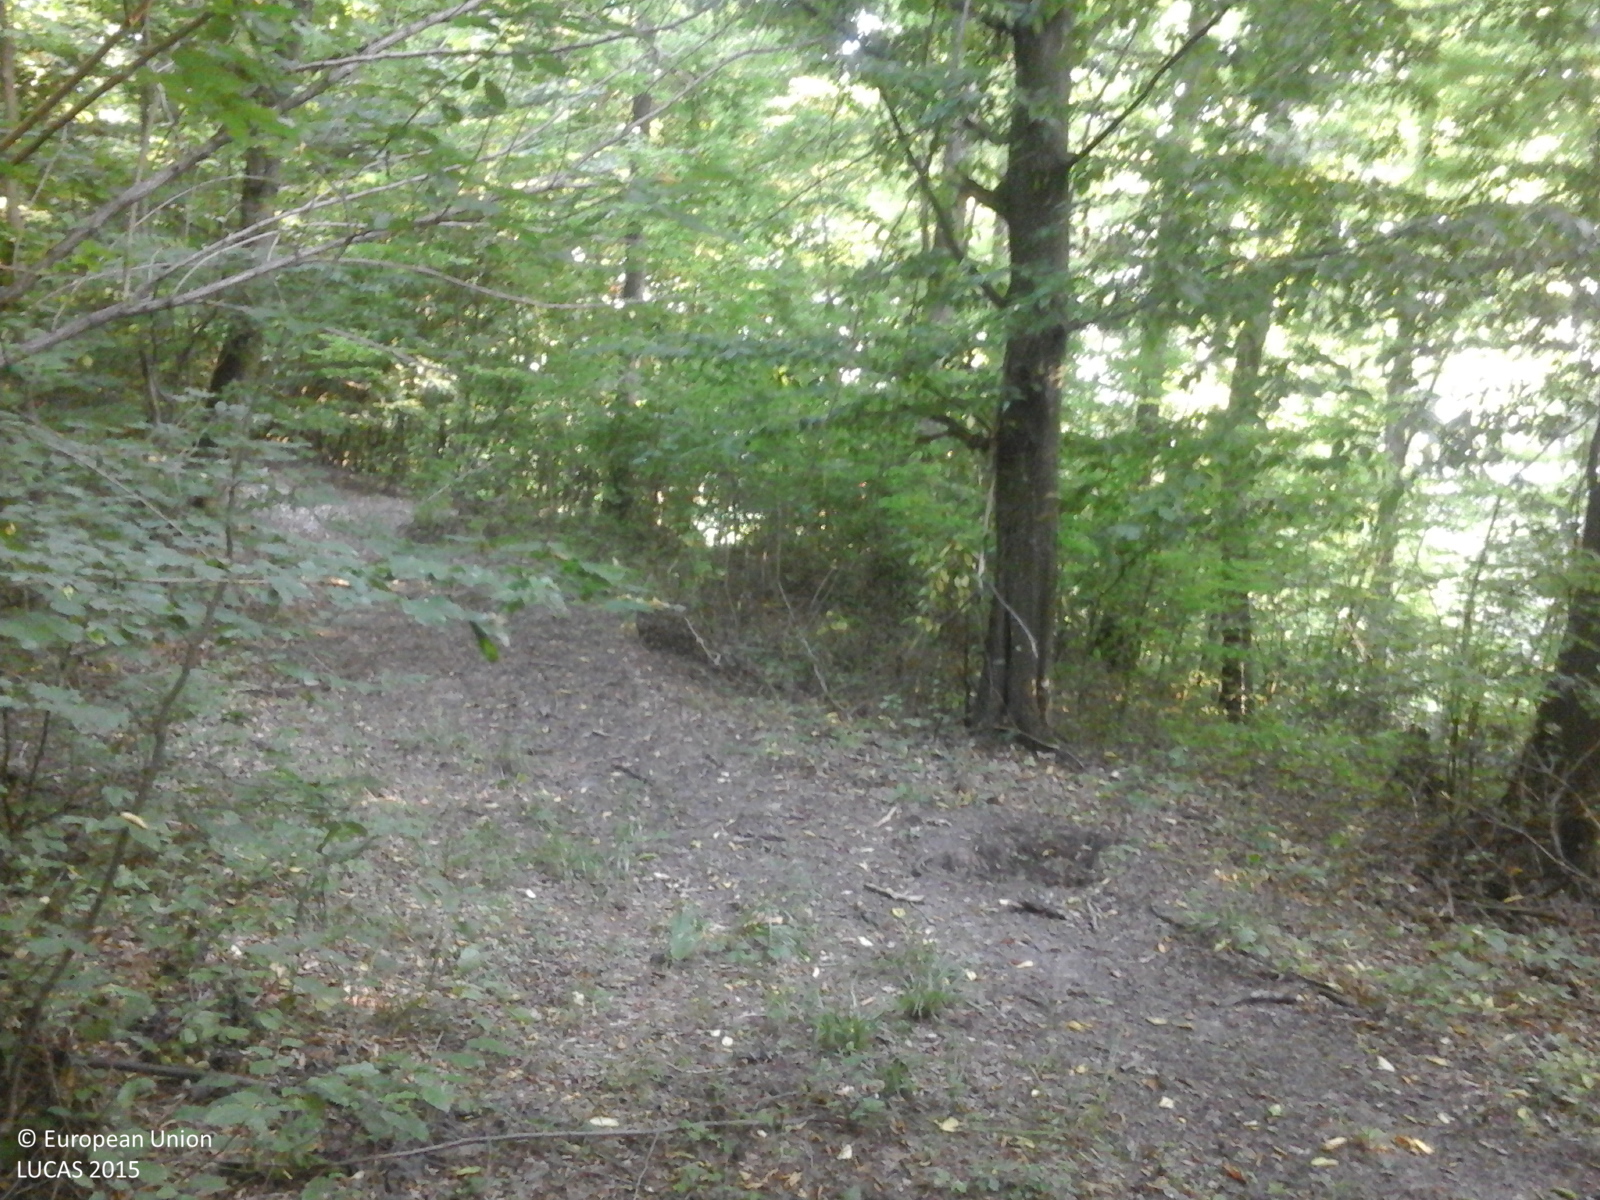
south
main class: Woodland
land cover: Broadleaved woodland
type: beech forest
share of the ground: > 75 %
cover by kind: broadleaved forest trees 95 %, herbaceous plants 5 %
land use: Forestry
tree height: > 5 m
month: July
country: RO
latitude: 45.0126
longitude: 24.7356
